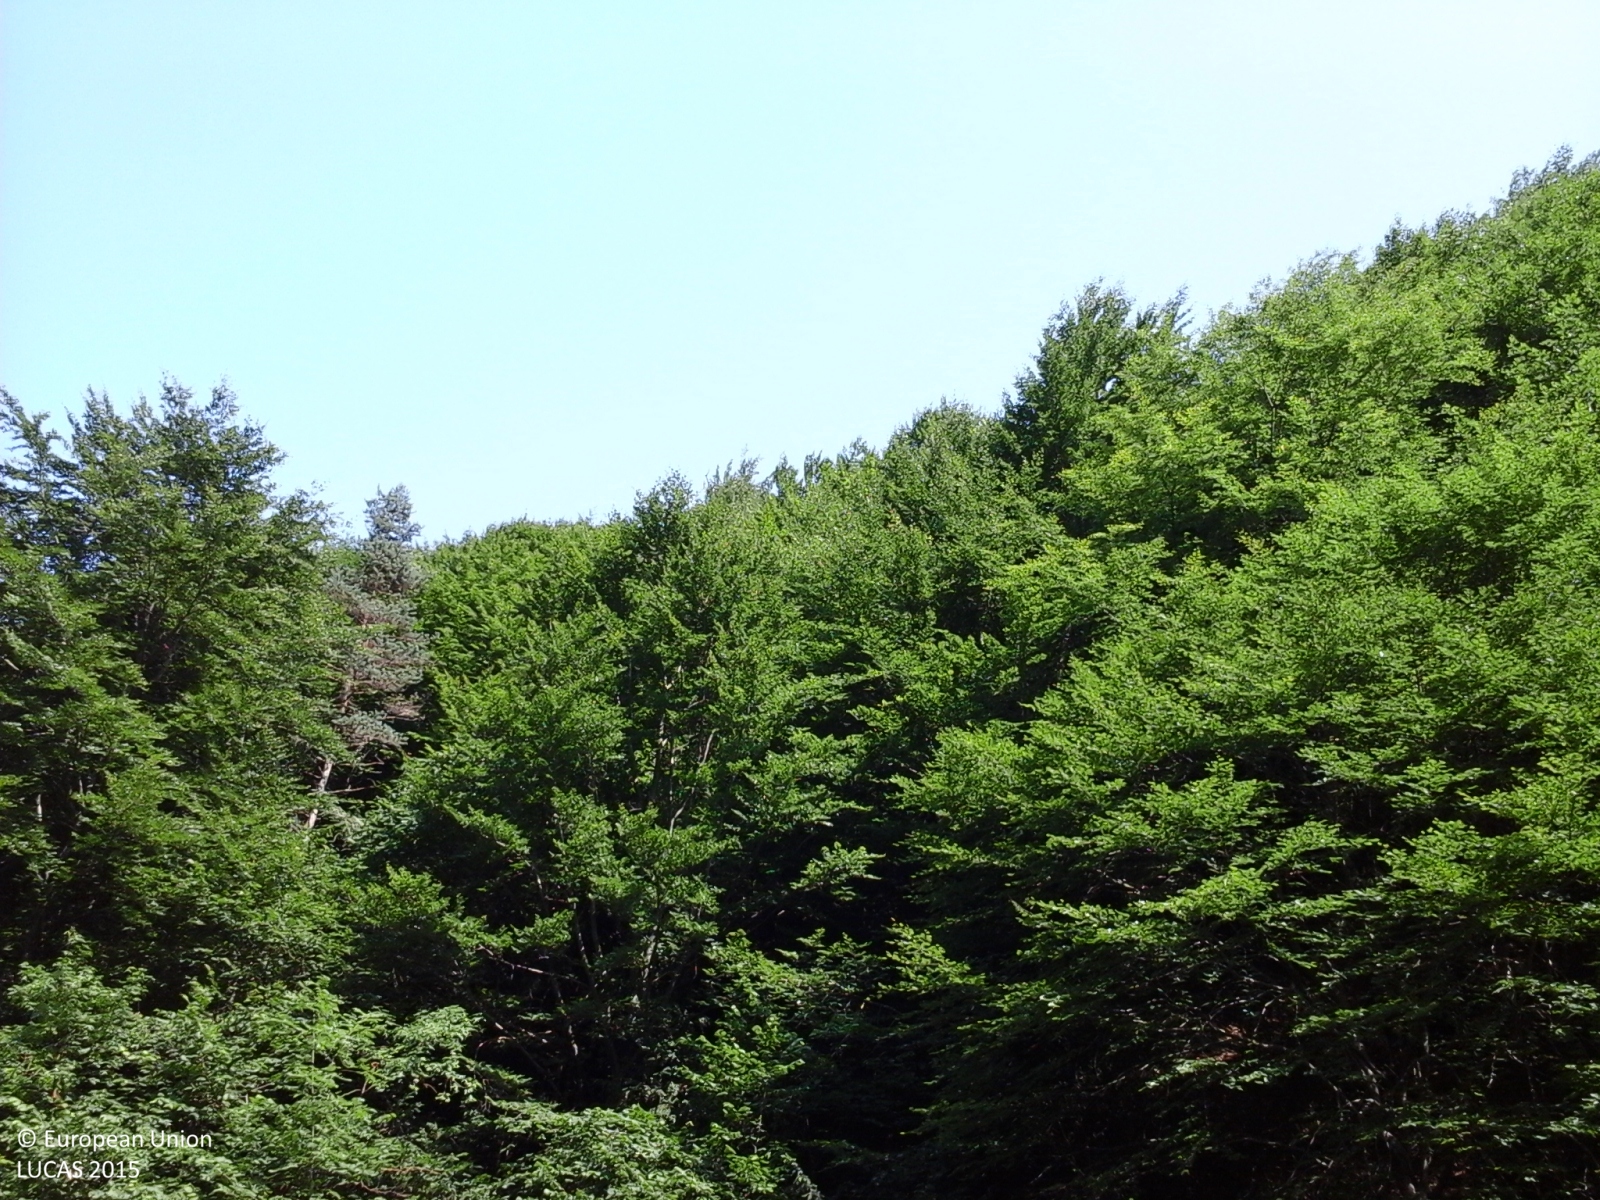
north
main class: Woodland
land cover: Other mixed woodland
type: mountainous beech forest
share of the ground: > 75 %
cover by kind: broadleaved forest trees 70 %, coniferous forest trees 30 %
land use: Semi-natural and natural areas not in use
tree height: > 5 m
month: July
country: IT
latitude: 44.4586
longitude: 7.2531
